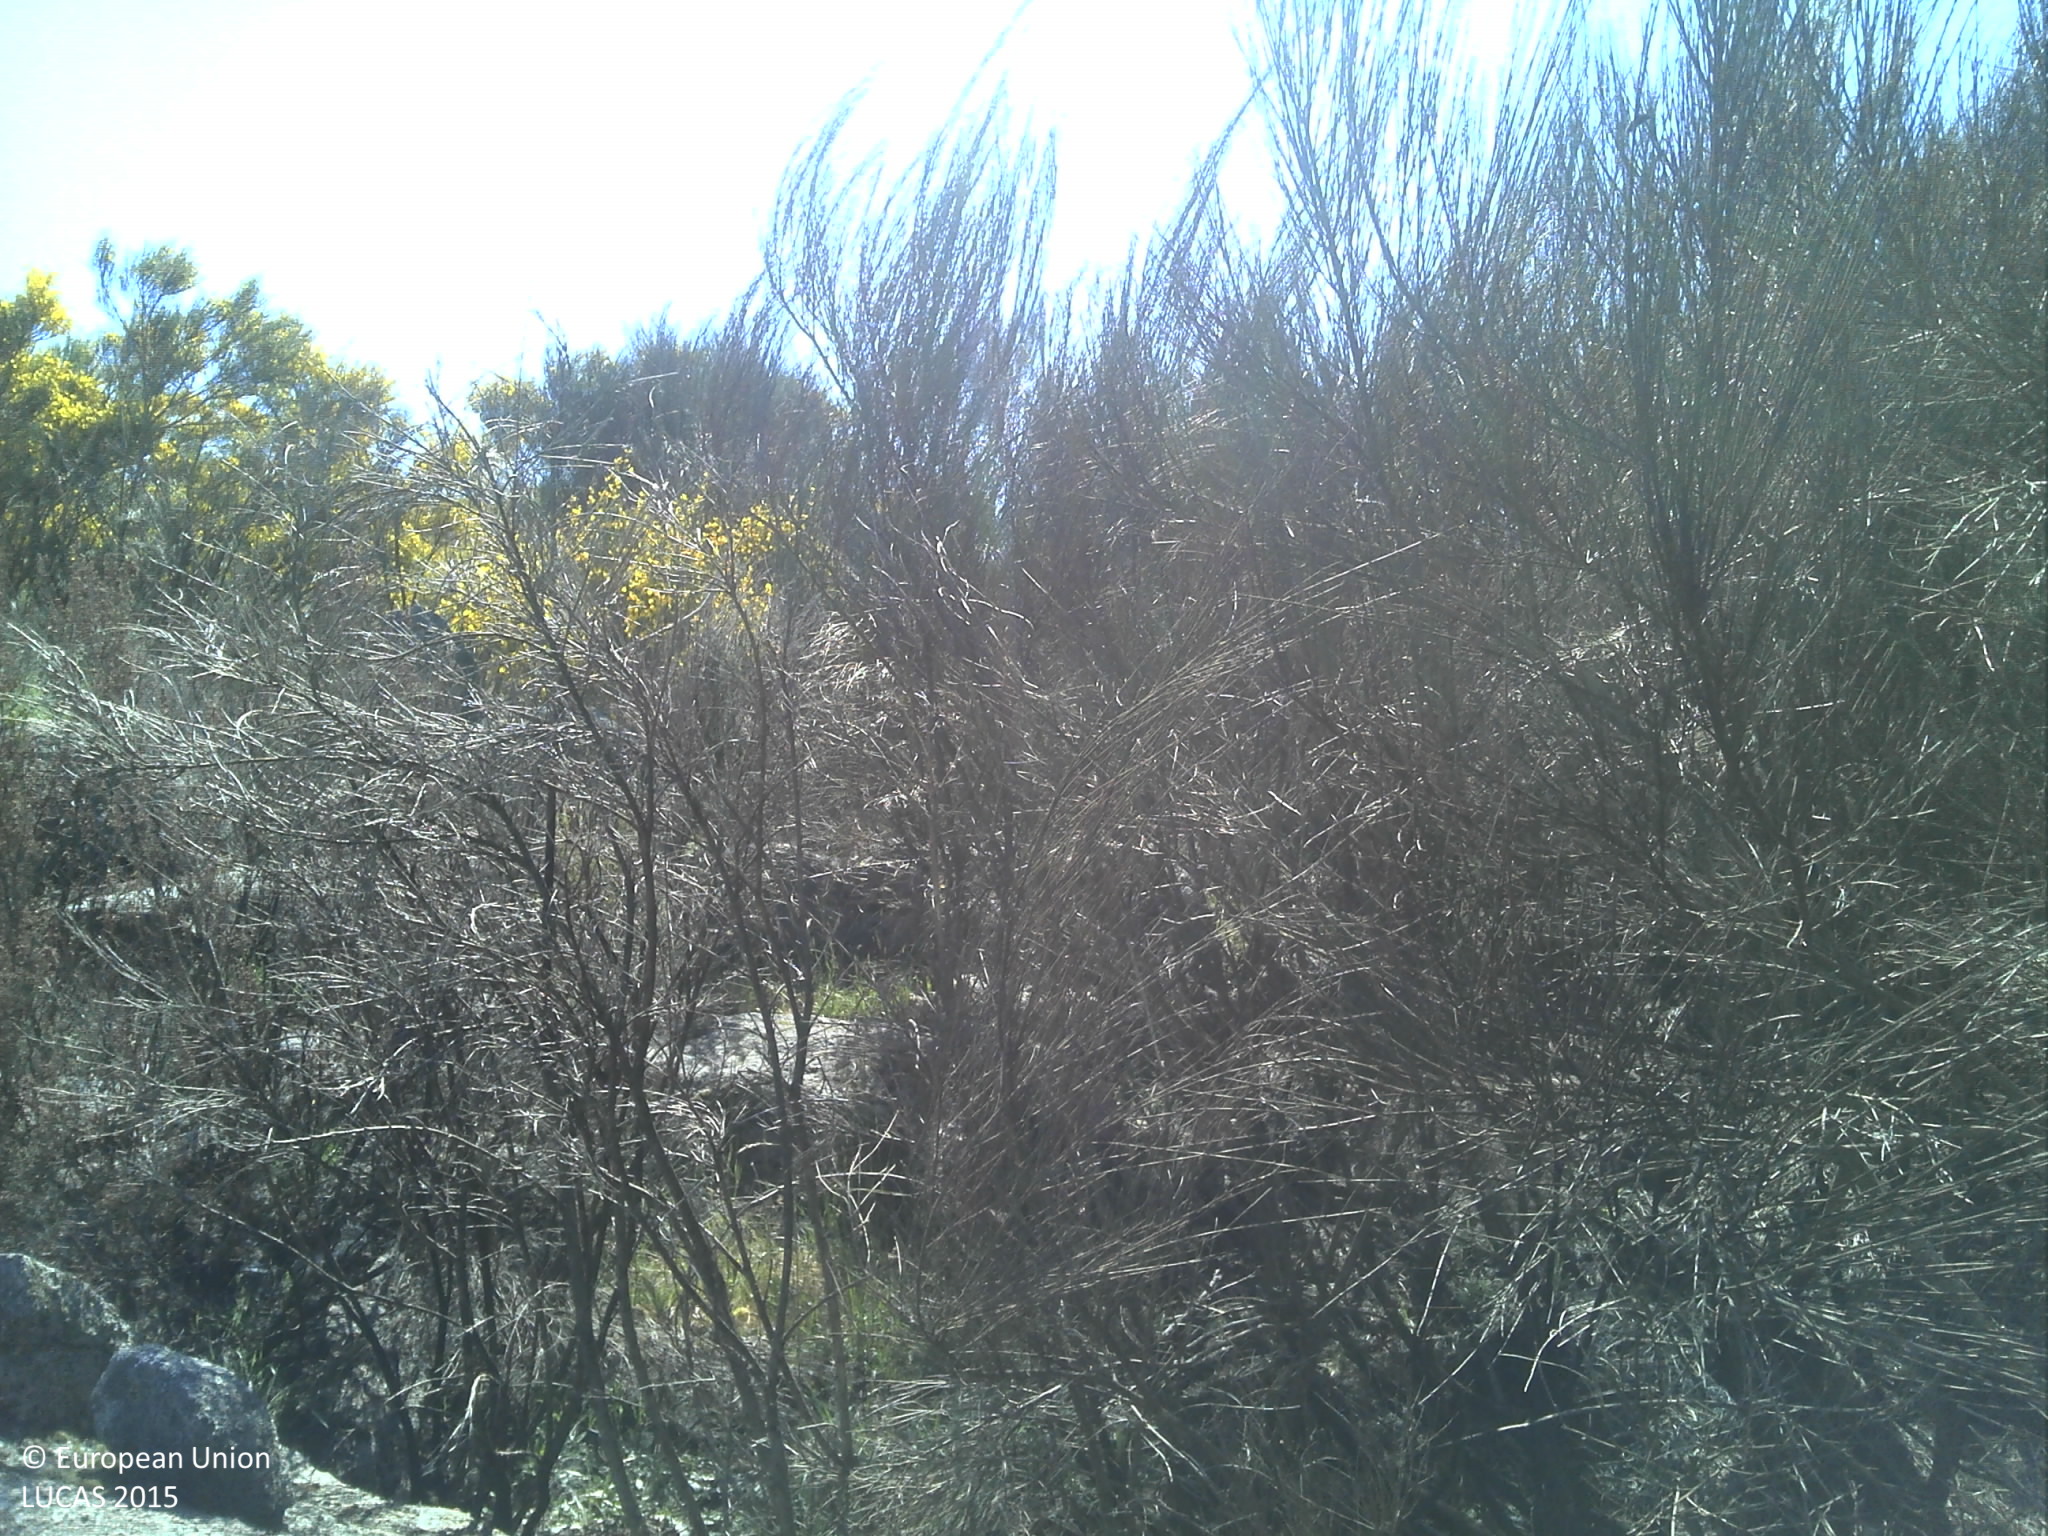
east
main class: Shrubland
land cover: Shrubland without tree cover
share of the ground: 50 - 75 %
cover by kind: shrubs 65 %, unconsolidated bare surface 20 %, herbaceous plants 5 %
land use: Semi-natural and natural areas not in use
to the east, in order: Shrubland without tree cover
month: May
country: PT
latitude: 40.5295
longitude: -7.3791
